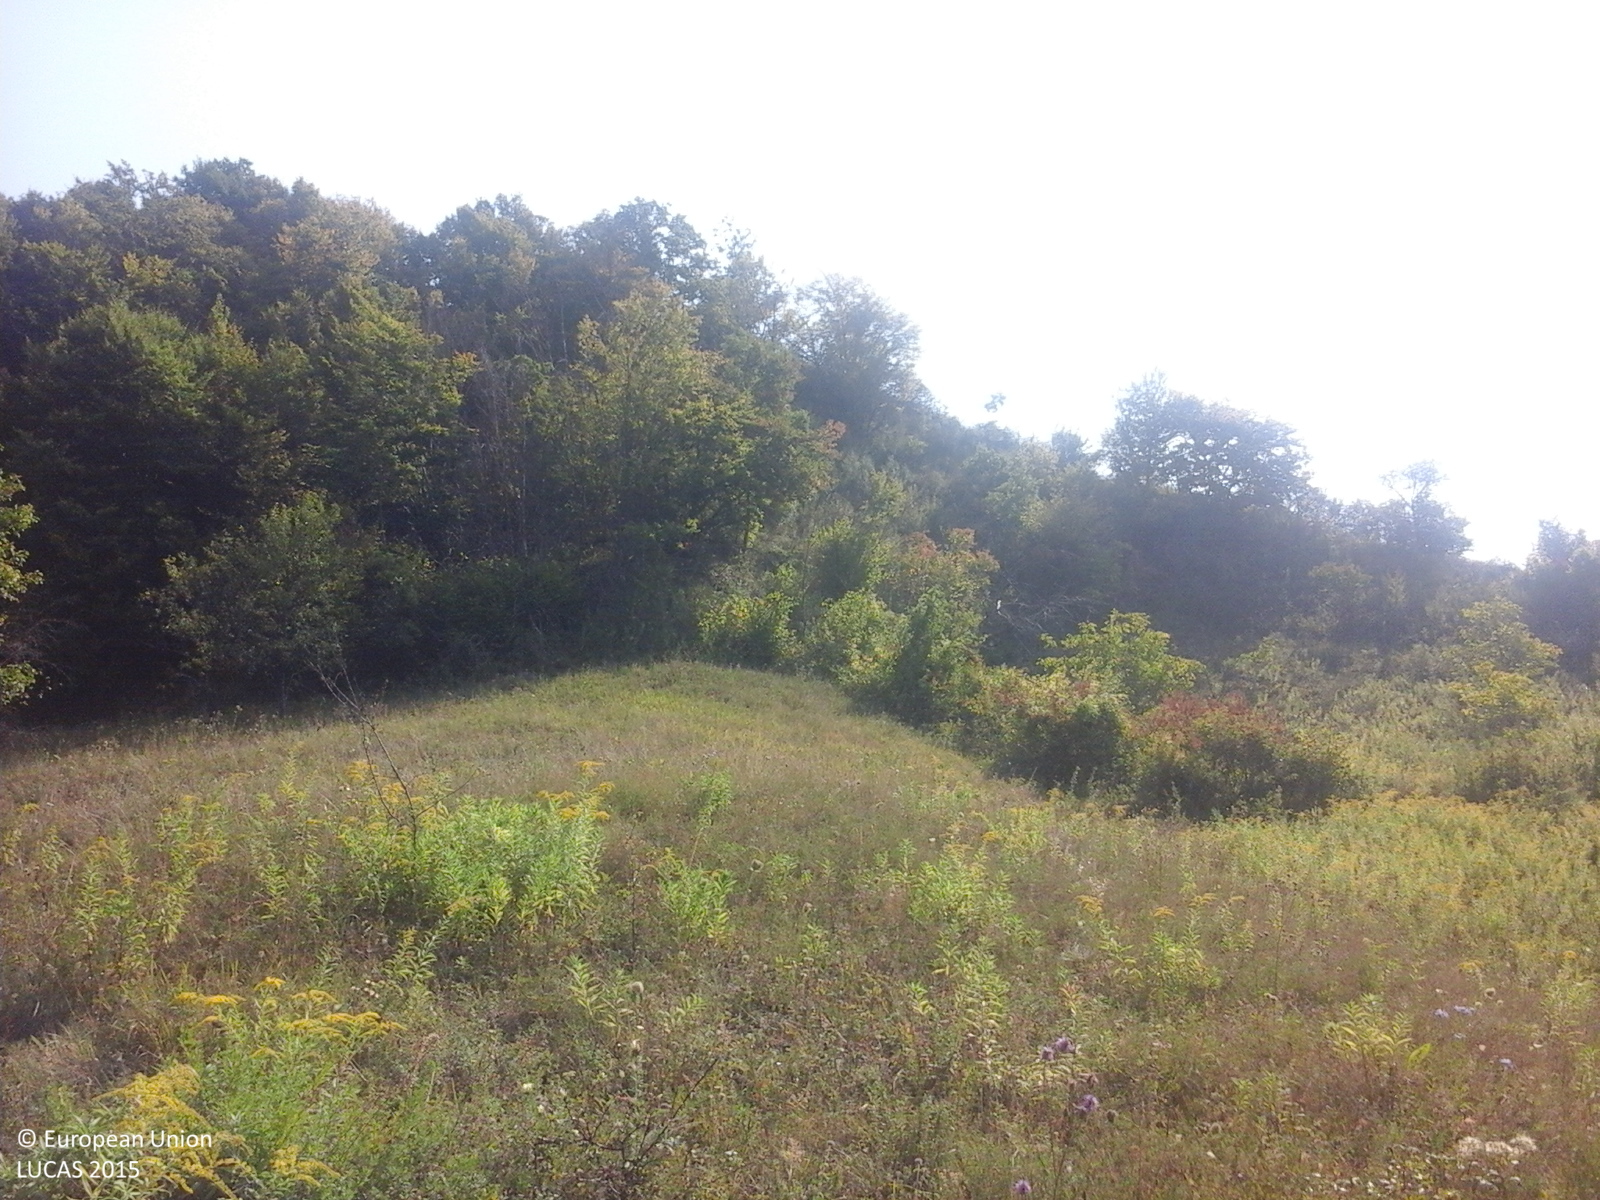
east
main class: Grassland
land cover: Spontaneously vegetated surfaces
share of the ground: > 75 %
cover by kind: herbaceous plants 100 %
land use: Fallow land
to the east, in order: Spontaneously vegetated surfaces; Broadleaved woodland; Grassland with sparse tree/shrub cover; Grassland without tree/shrub cover; Broadleaved woodland
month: September
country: RO
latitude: 47.1478
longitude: 24.3705
